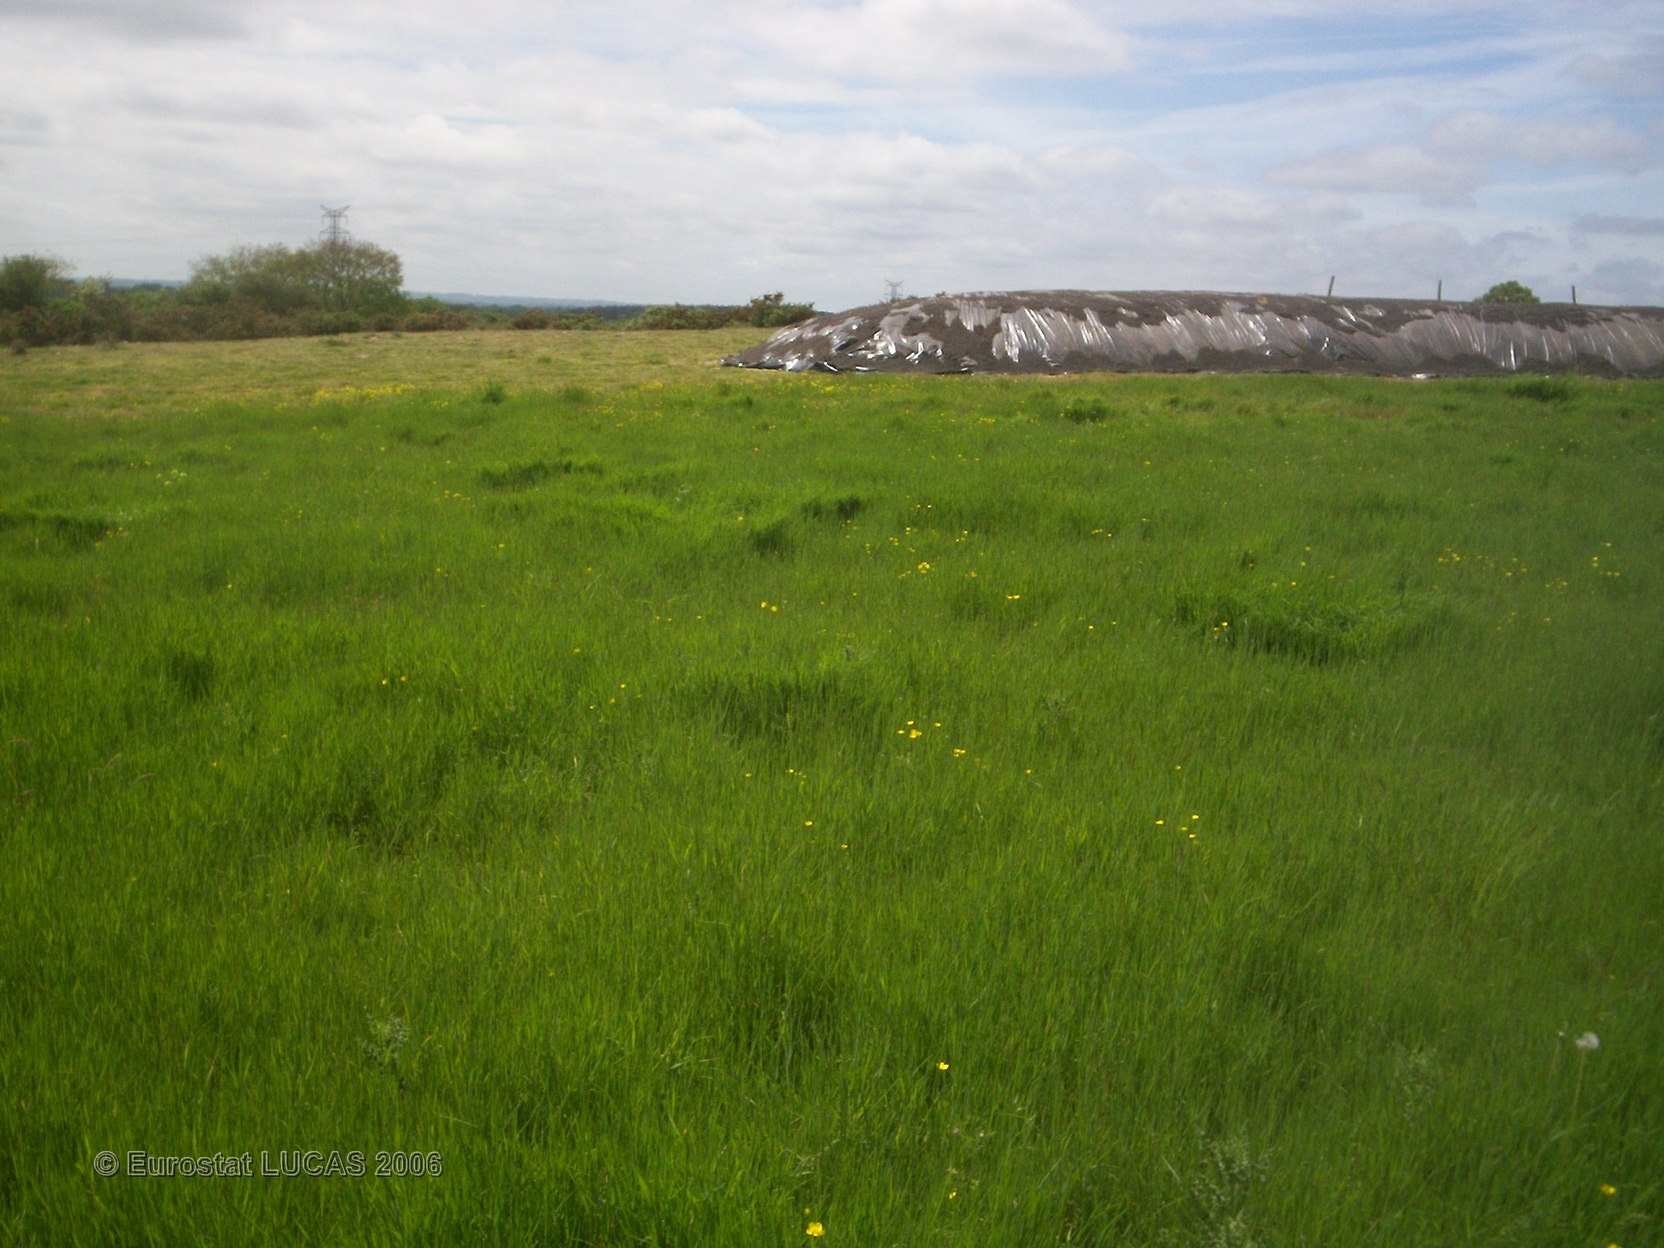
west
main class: Grassland
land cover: Grassland without tree/shrub cover
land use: Agriculture (excluding fallow land and kitchen gardens)
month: May
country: FR
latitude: 47.6728
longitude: -1.5113
